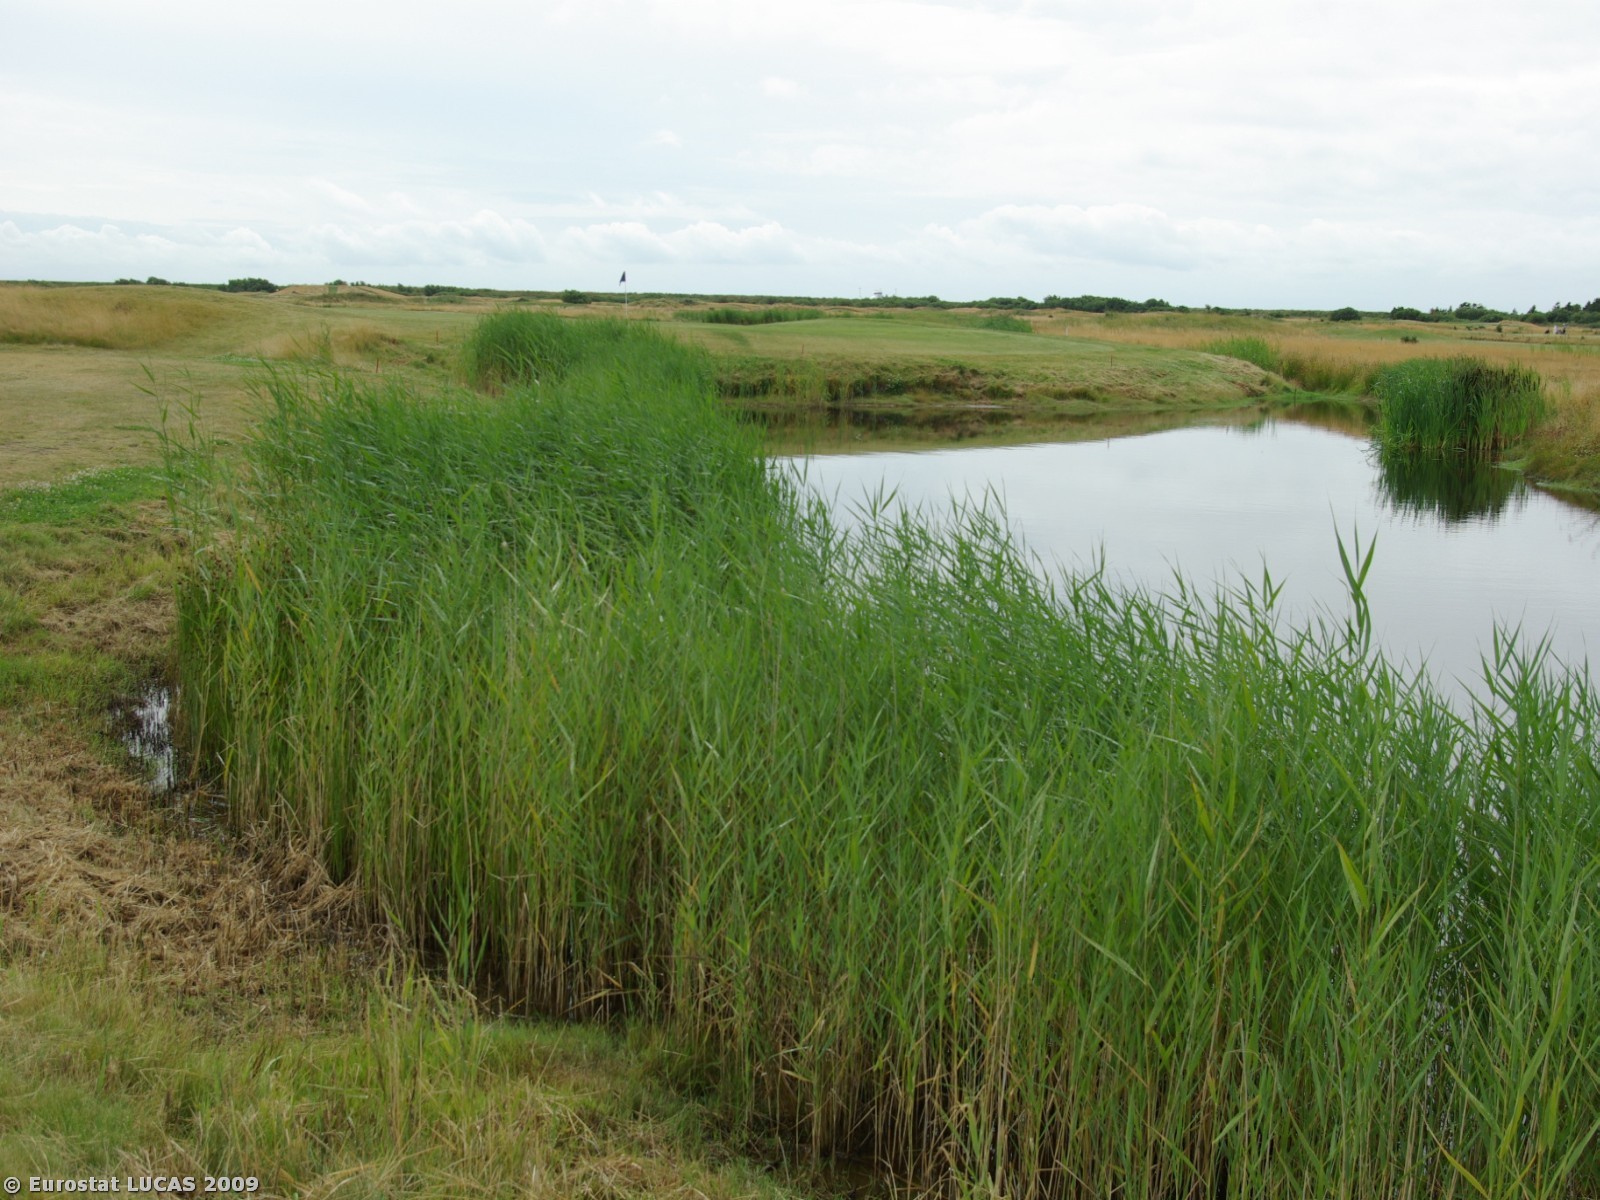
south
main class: Grassland
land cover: Grassland without tree/shrub cover
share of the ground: > 75 %
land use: Sport
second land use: Amenities, museums, leisure
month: July
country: DK
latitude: 55.0829
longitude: 8.5442
